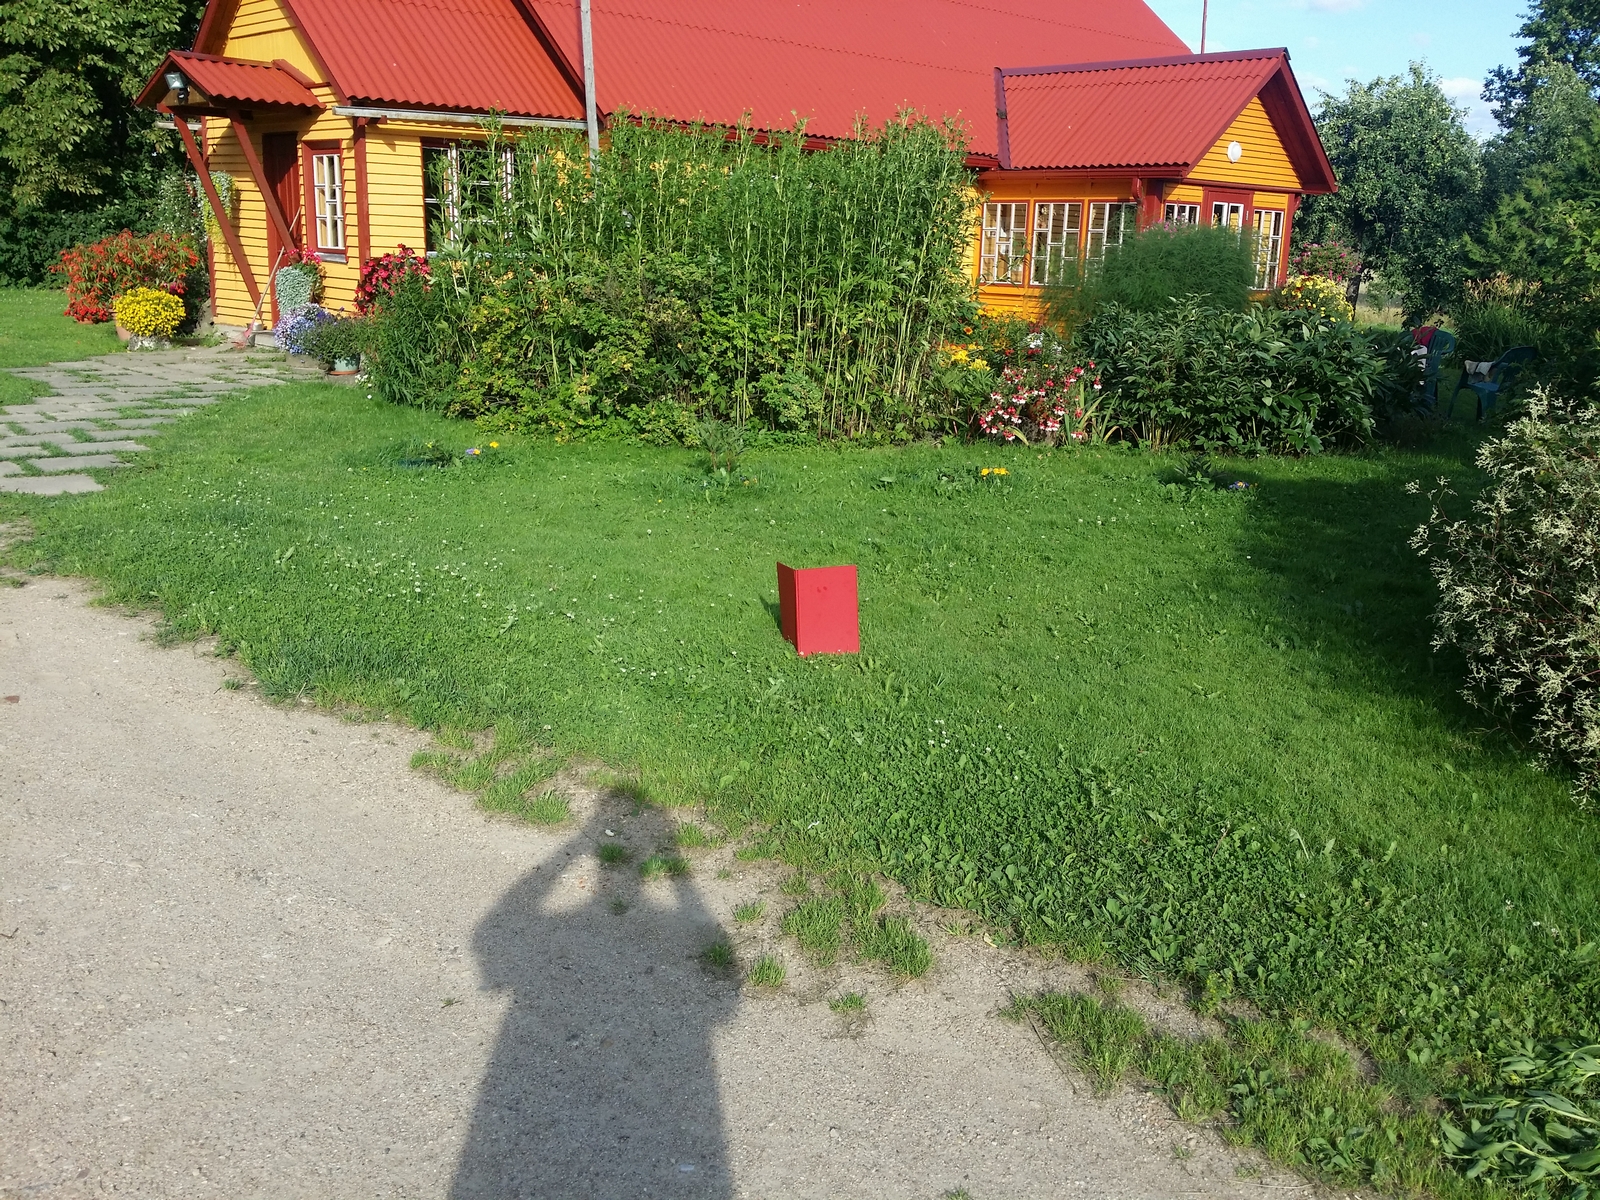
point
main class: Grassland
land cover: Grassland without tree/shrub cover
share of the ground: > 75 %
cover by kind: herbaceous plants 100 %
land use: Residential
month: July
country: LV
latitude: 57.1818
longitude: 27.2572
